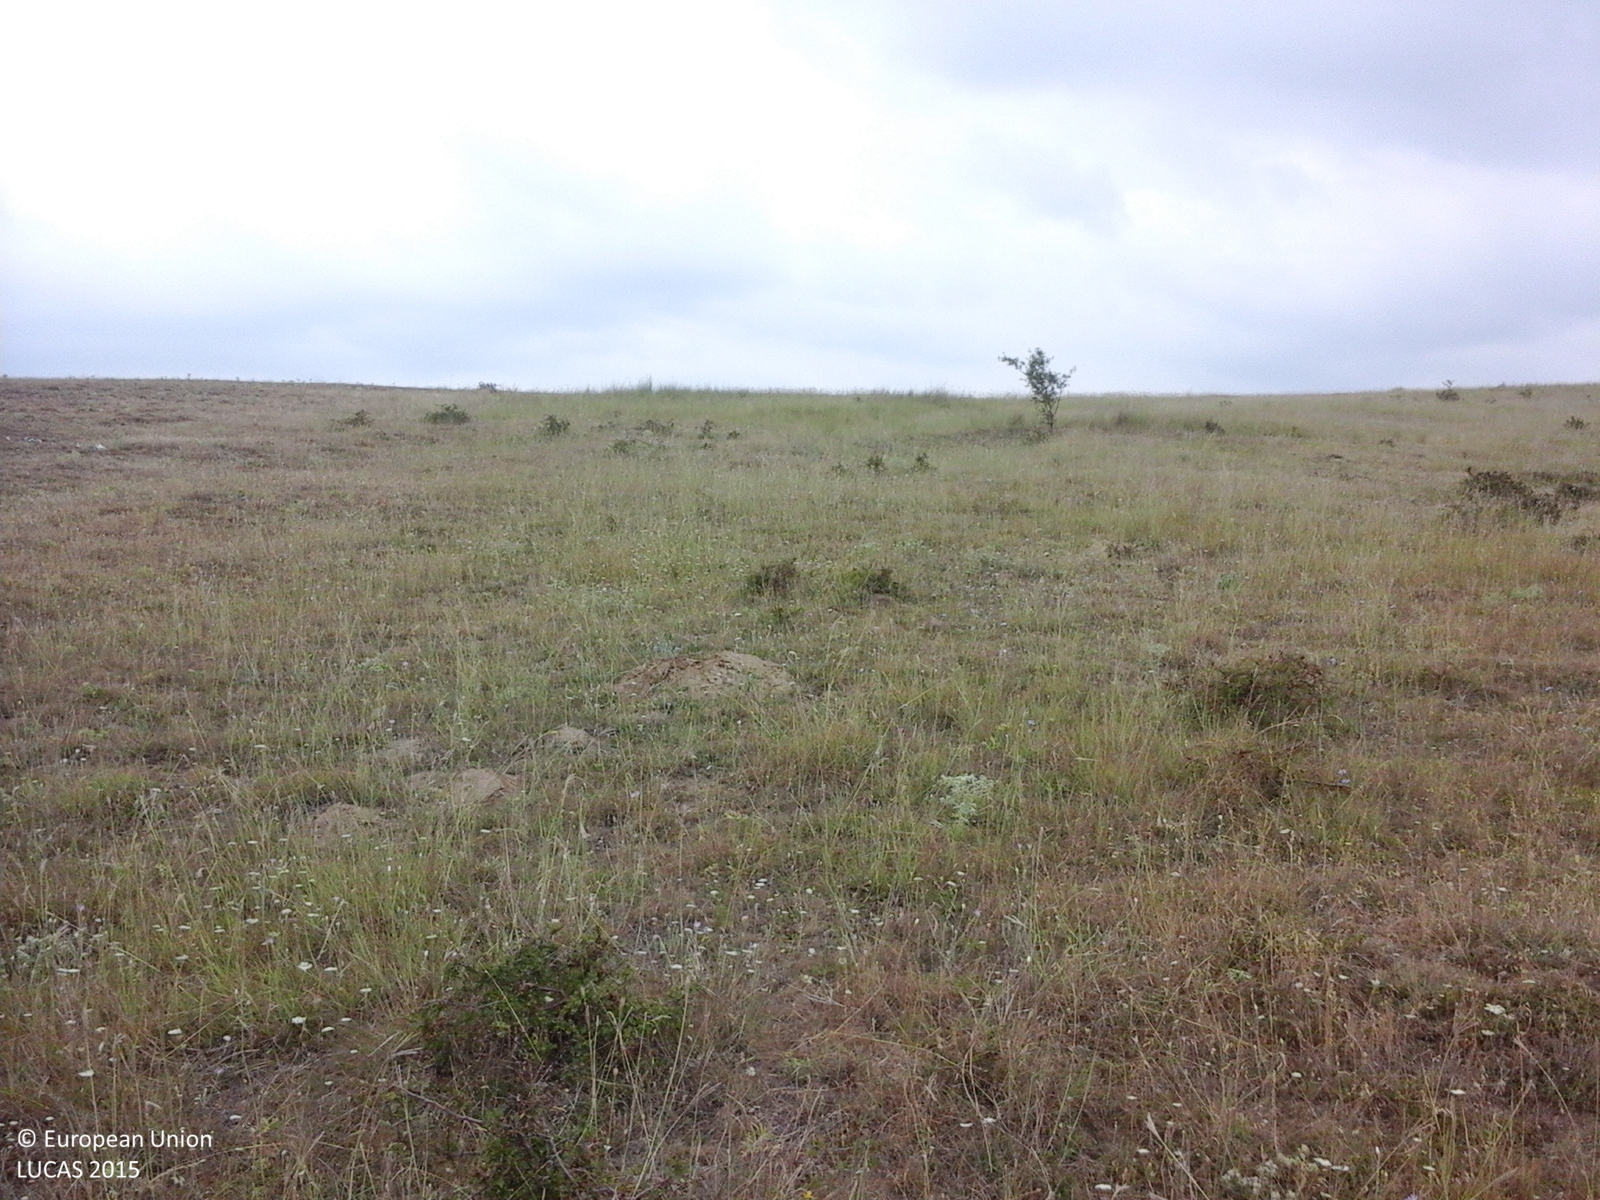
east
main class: Grassland
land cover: Grassland with sparse tree/shrub cover
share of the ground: > 75 %
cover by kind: herbaceous plants 95 %, broadleaved forest trees 5 %
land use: Agriculture (excluding fallow land and kitchen gardens)
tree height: < 5 m
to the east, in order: Grassland with sparse tree/shrub cover; Grassland without tree/shrub cover; Grassland with sparse tree/shrub cover
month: July
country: RO
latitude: 44.9425
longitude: 28.2818
